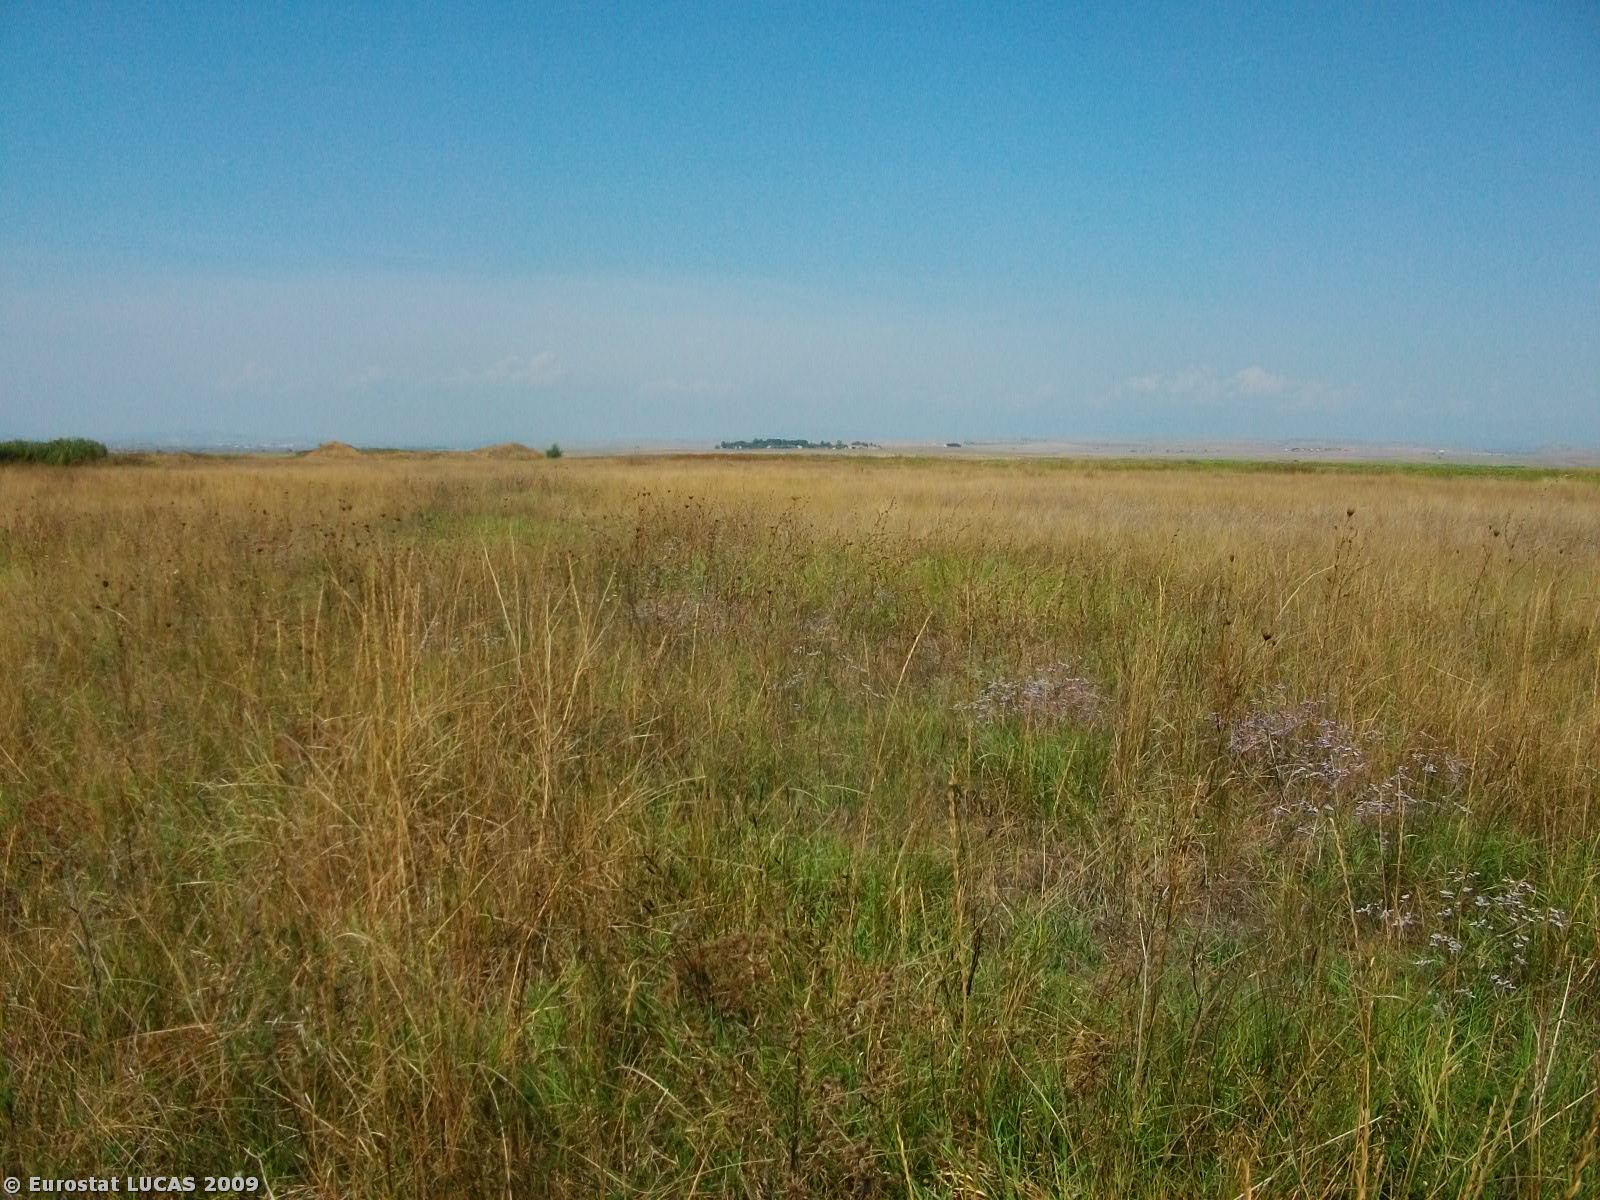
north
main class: Grassland
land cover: Grassland without tree/shrub cover
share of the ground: > 75 %
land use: Unused
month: September
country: GR
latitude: 40.8481
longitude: 22.6864
